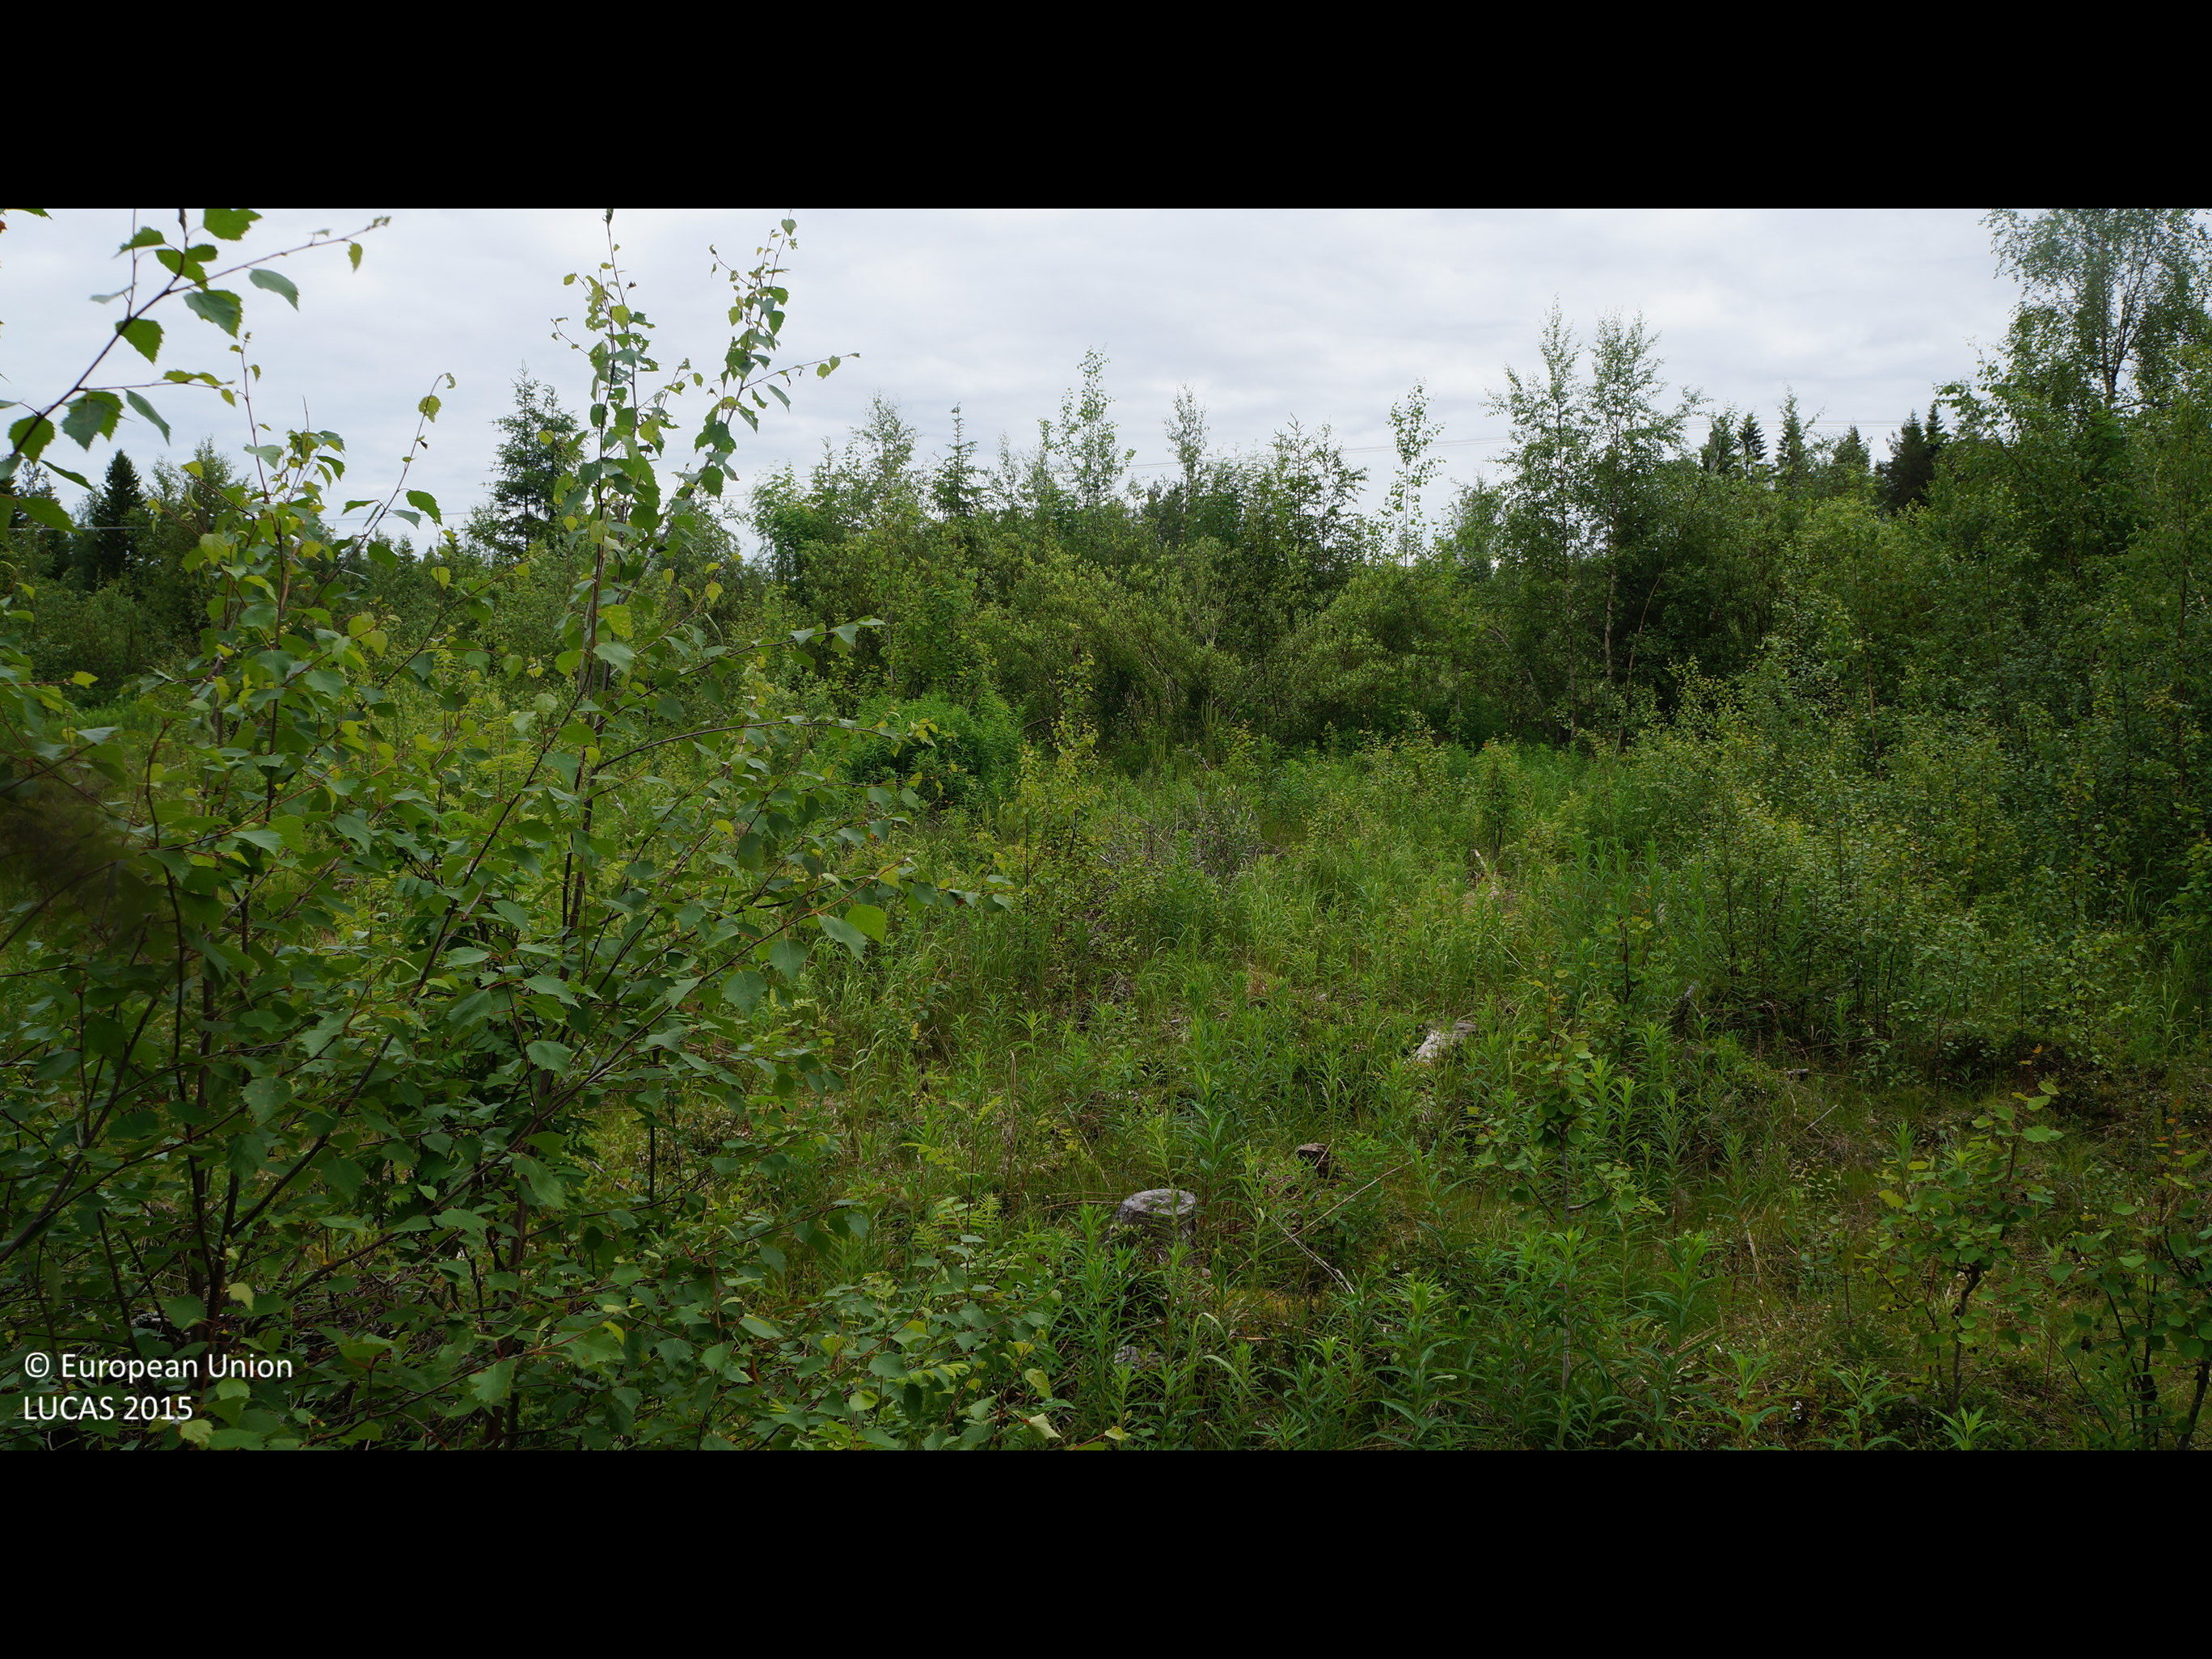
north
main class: Woodland
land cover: Other coniferous woodland
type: boreal forest
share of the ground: 25 - 50 %
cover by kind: shrubs 55 %, coniferous forest trees 35 %, herbaceous plants 5 %, lichens and mosses 5 %
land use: Forestry
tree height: > 5 m
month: July
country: FI
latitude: 64.2796
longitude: 24.5077
